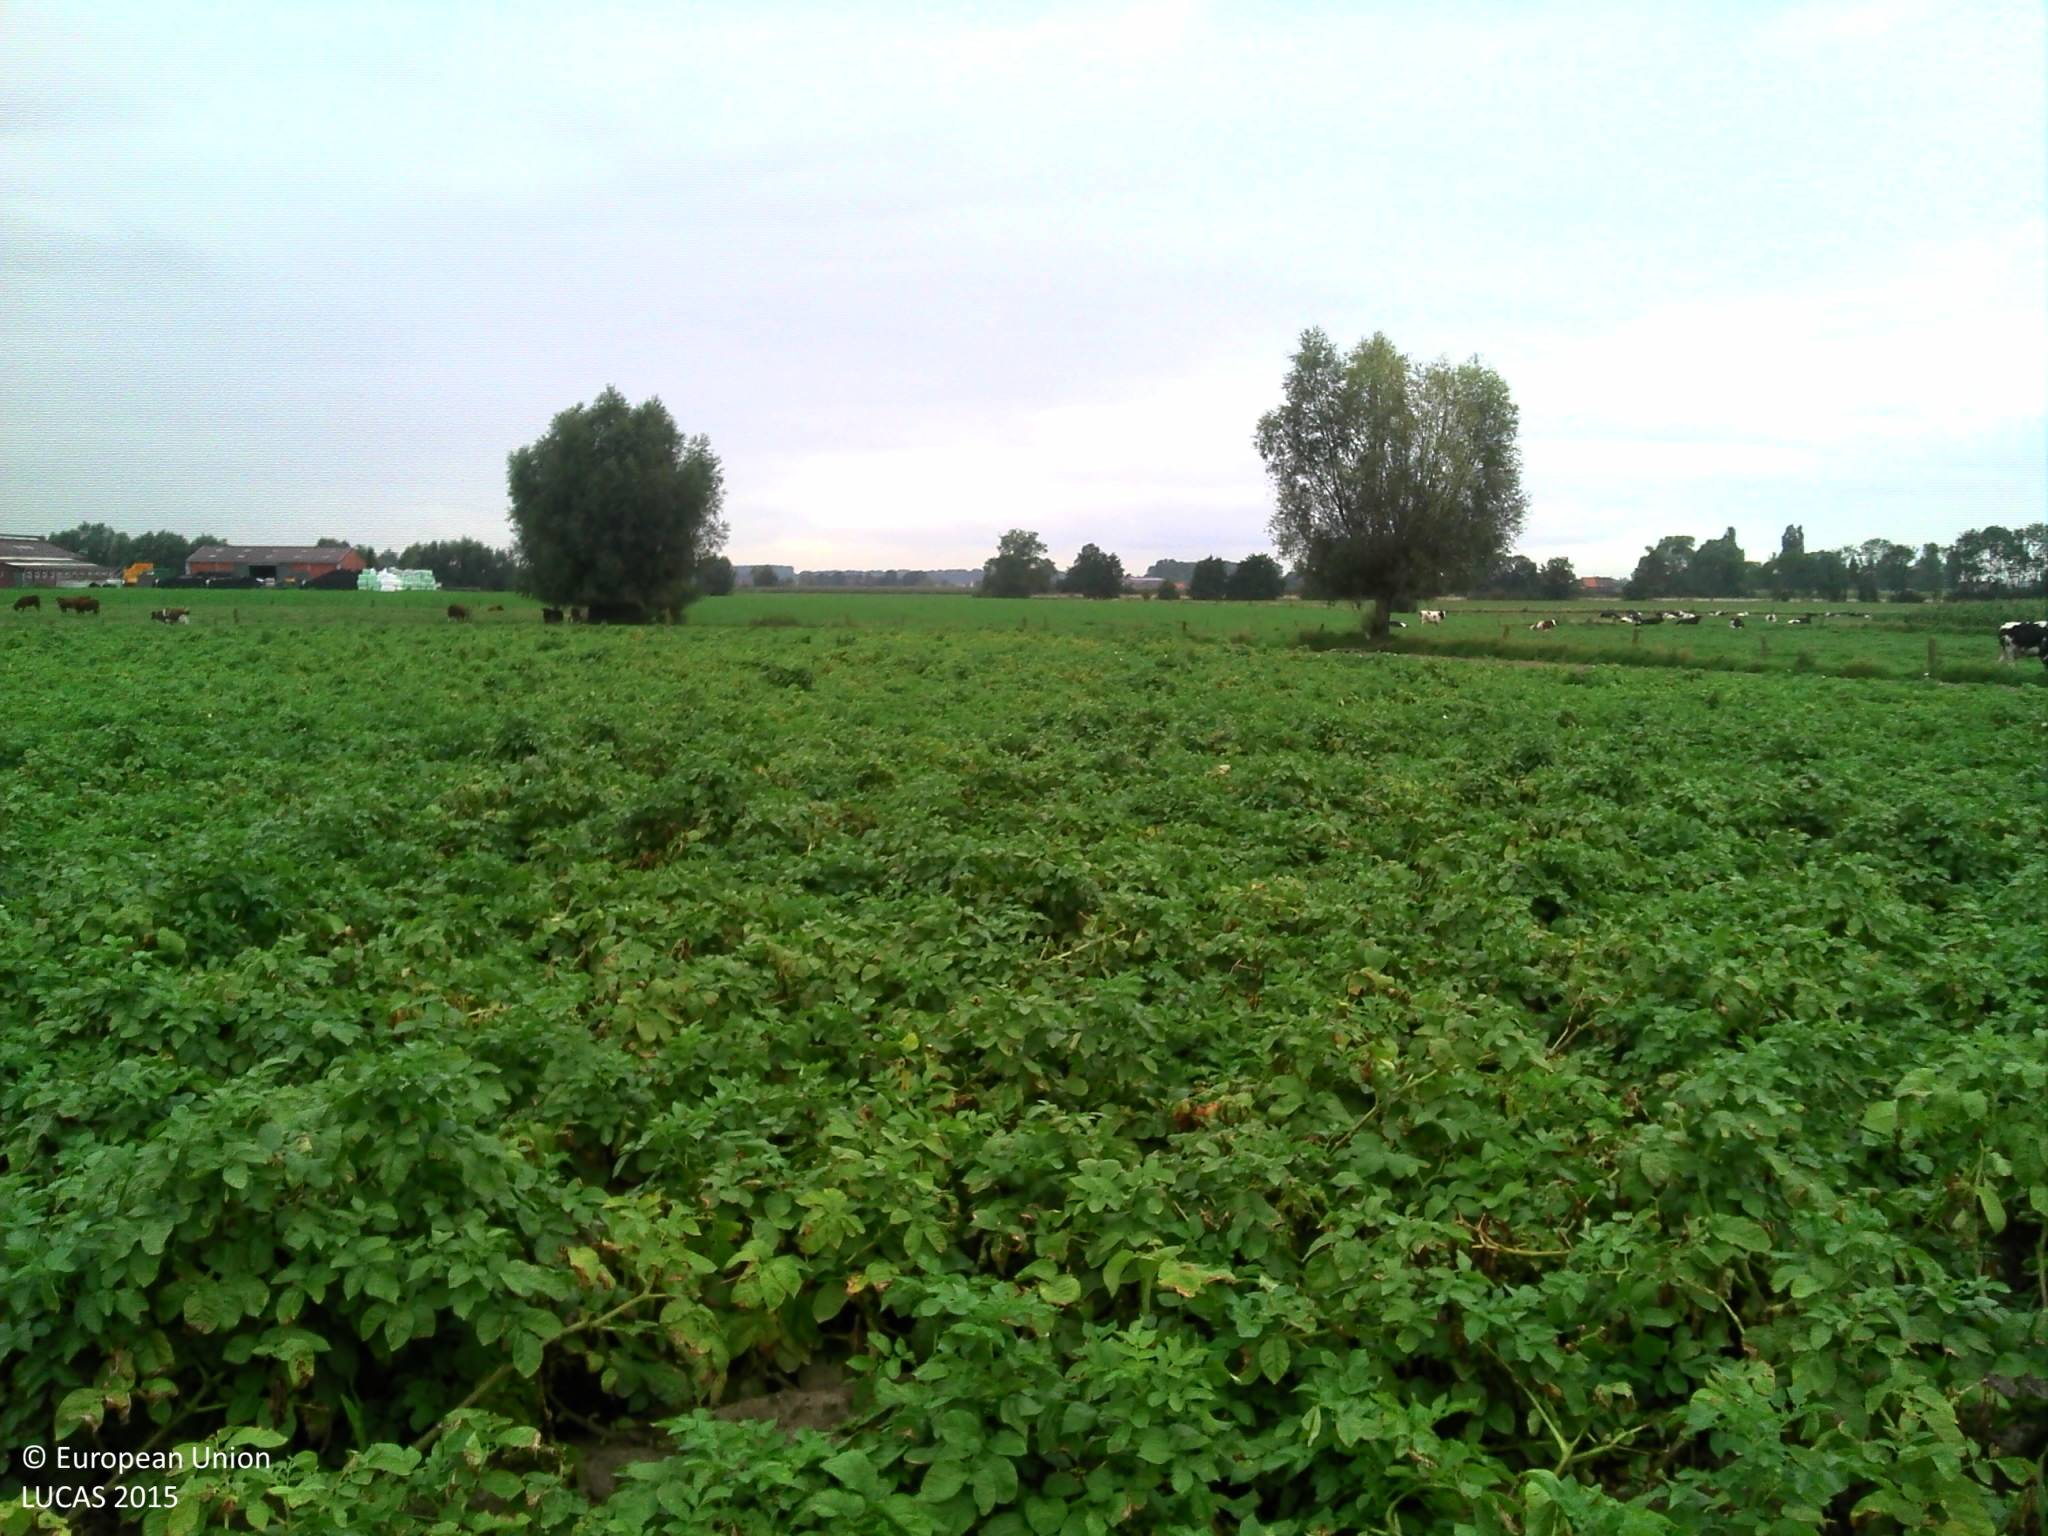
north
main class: Cropland
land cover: Potatoes
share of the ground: > 75 %
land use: Agriculture (excluding fallow land and kitchen gardens)
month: September
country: BE
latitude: 51.0062
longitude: 3.4505
